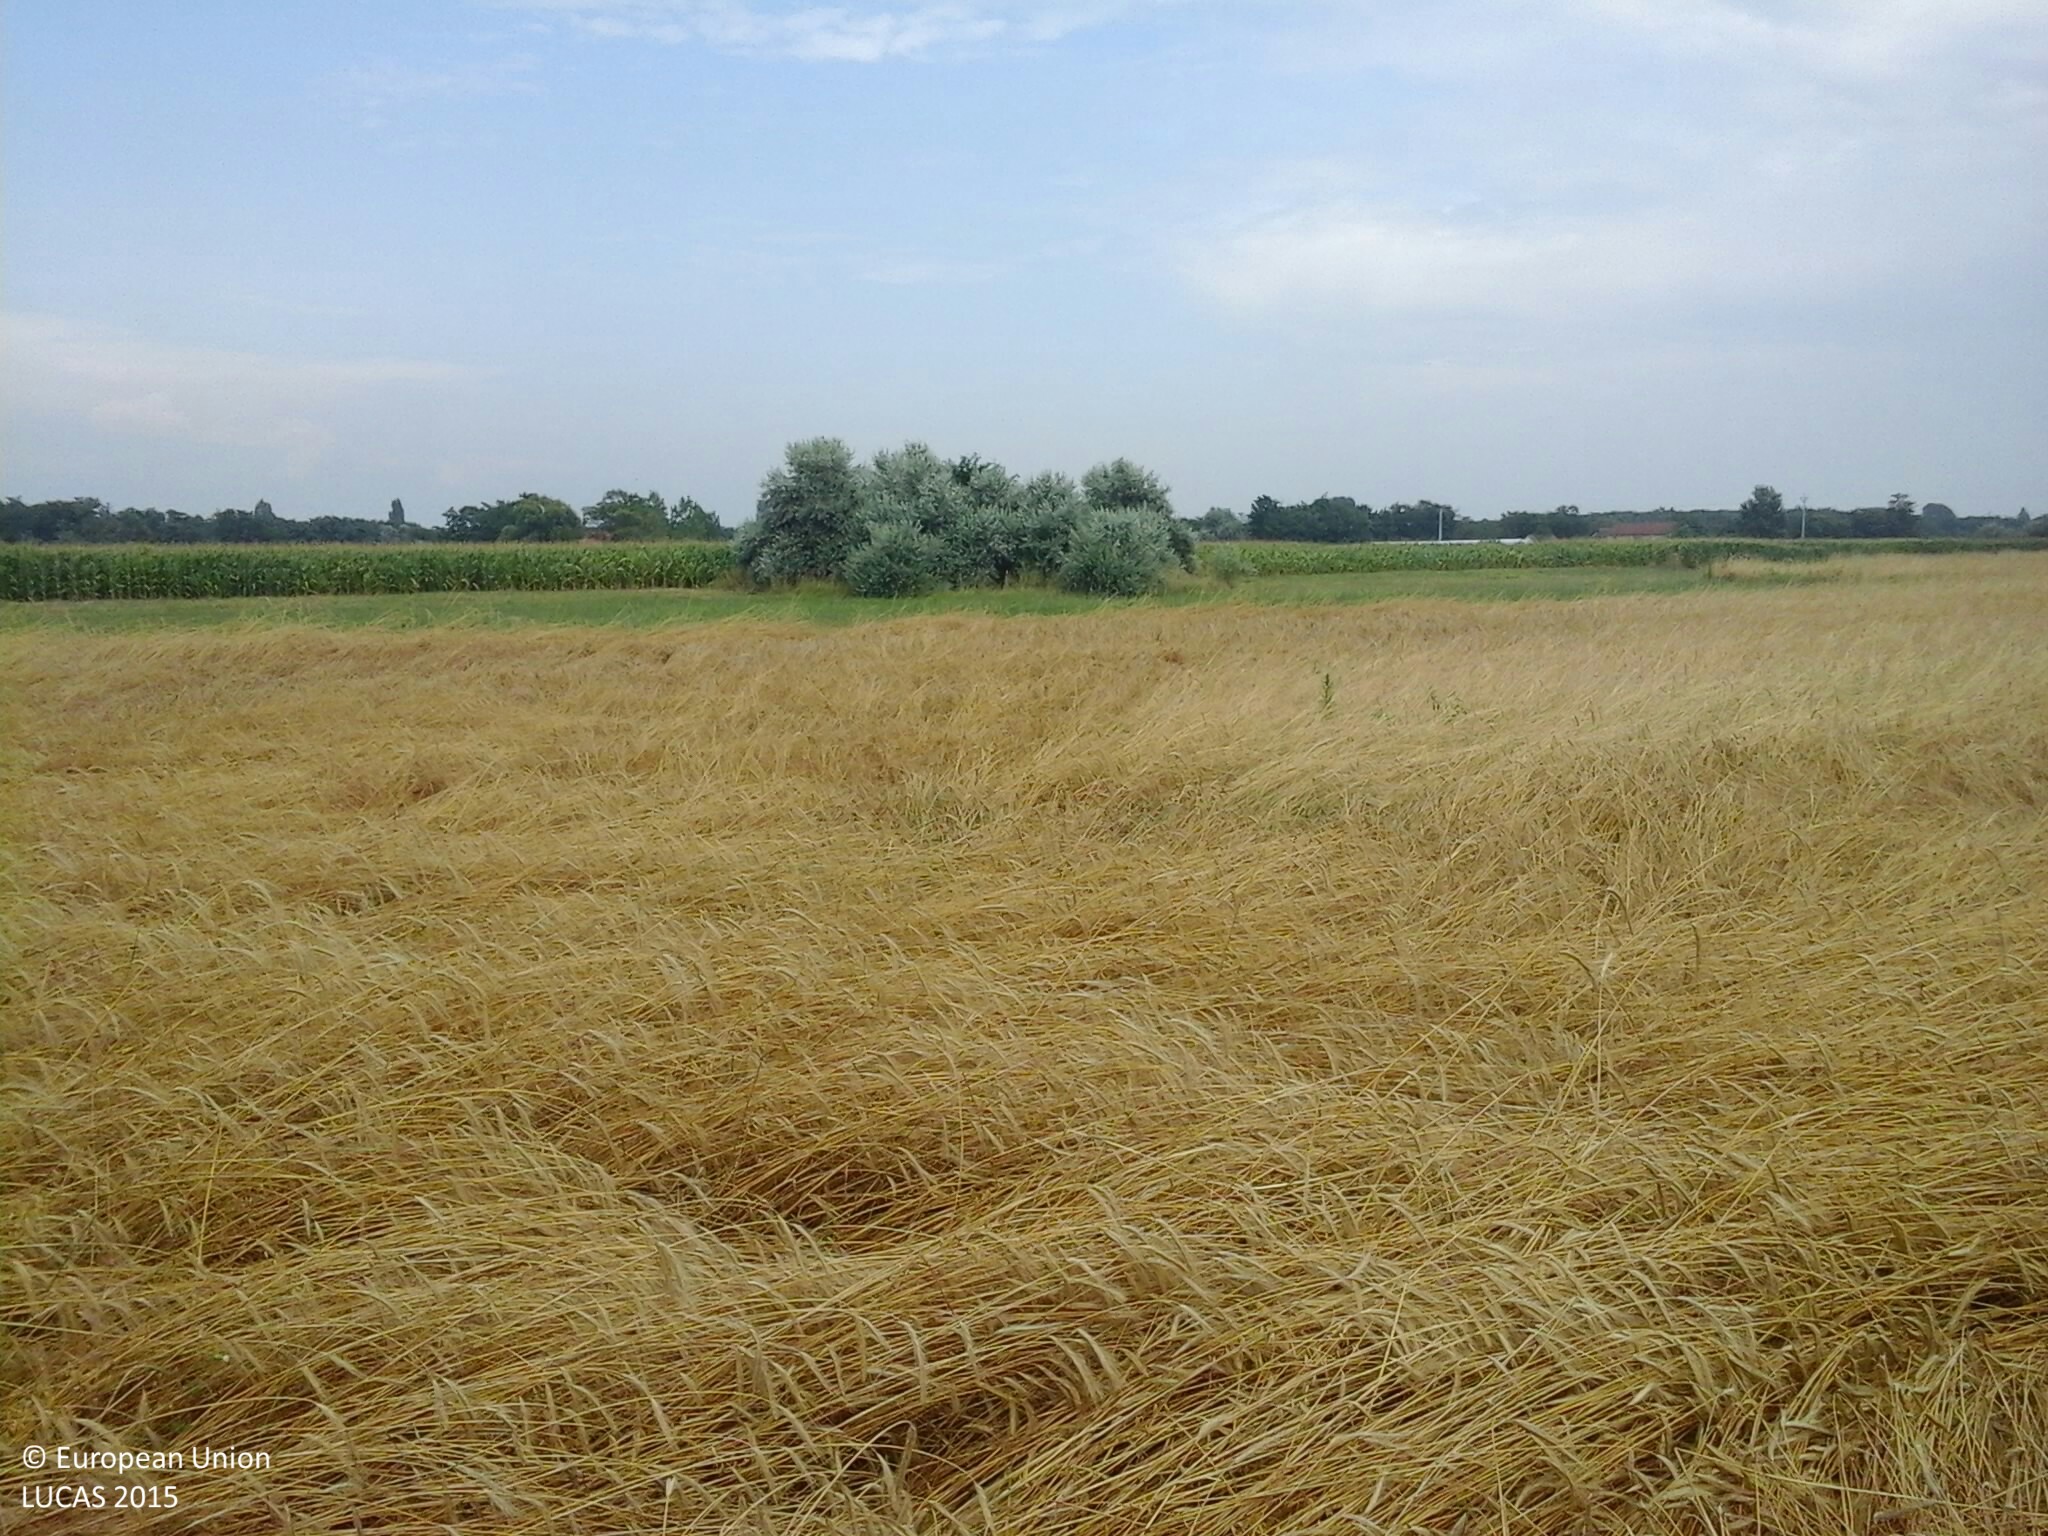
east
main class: Cropland
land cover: Triticale
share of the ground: > 75 %
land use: Agriculture (excluding fallow land and kitchen gardens)
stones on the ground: < 10 %
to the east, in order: Triticale; Grassland without tree/shrub cover; Maize; Spontaneously vegetated surfaces; Inland marshes
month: July
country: HU
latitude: 46.4409
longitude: 20.0312
